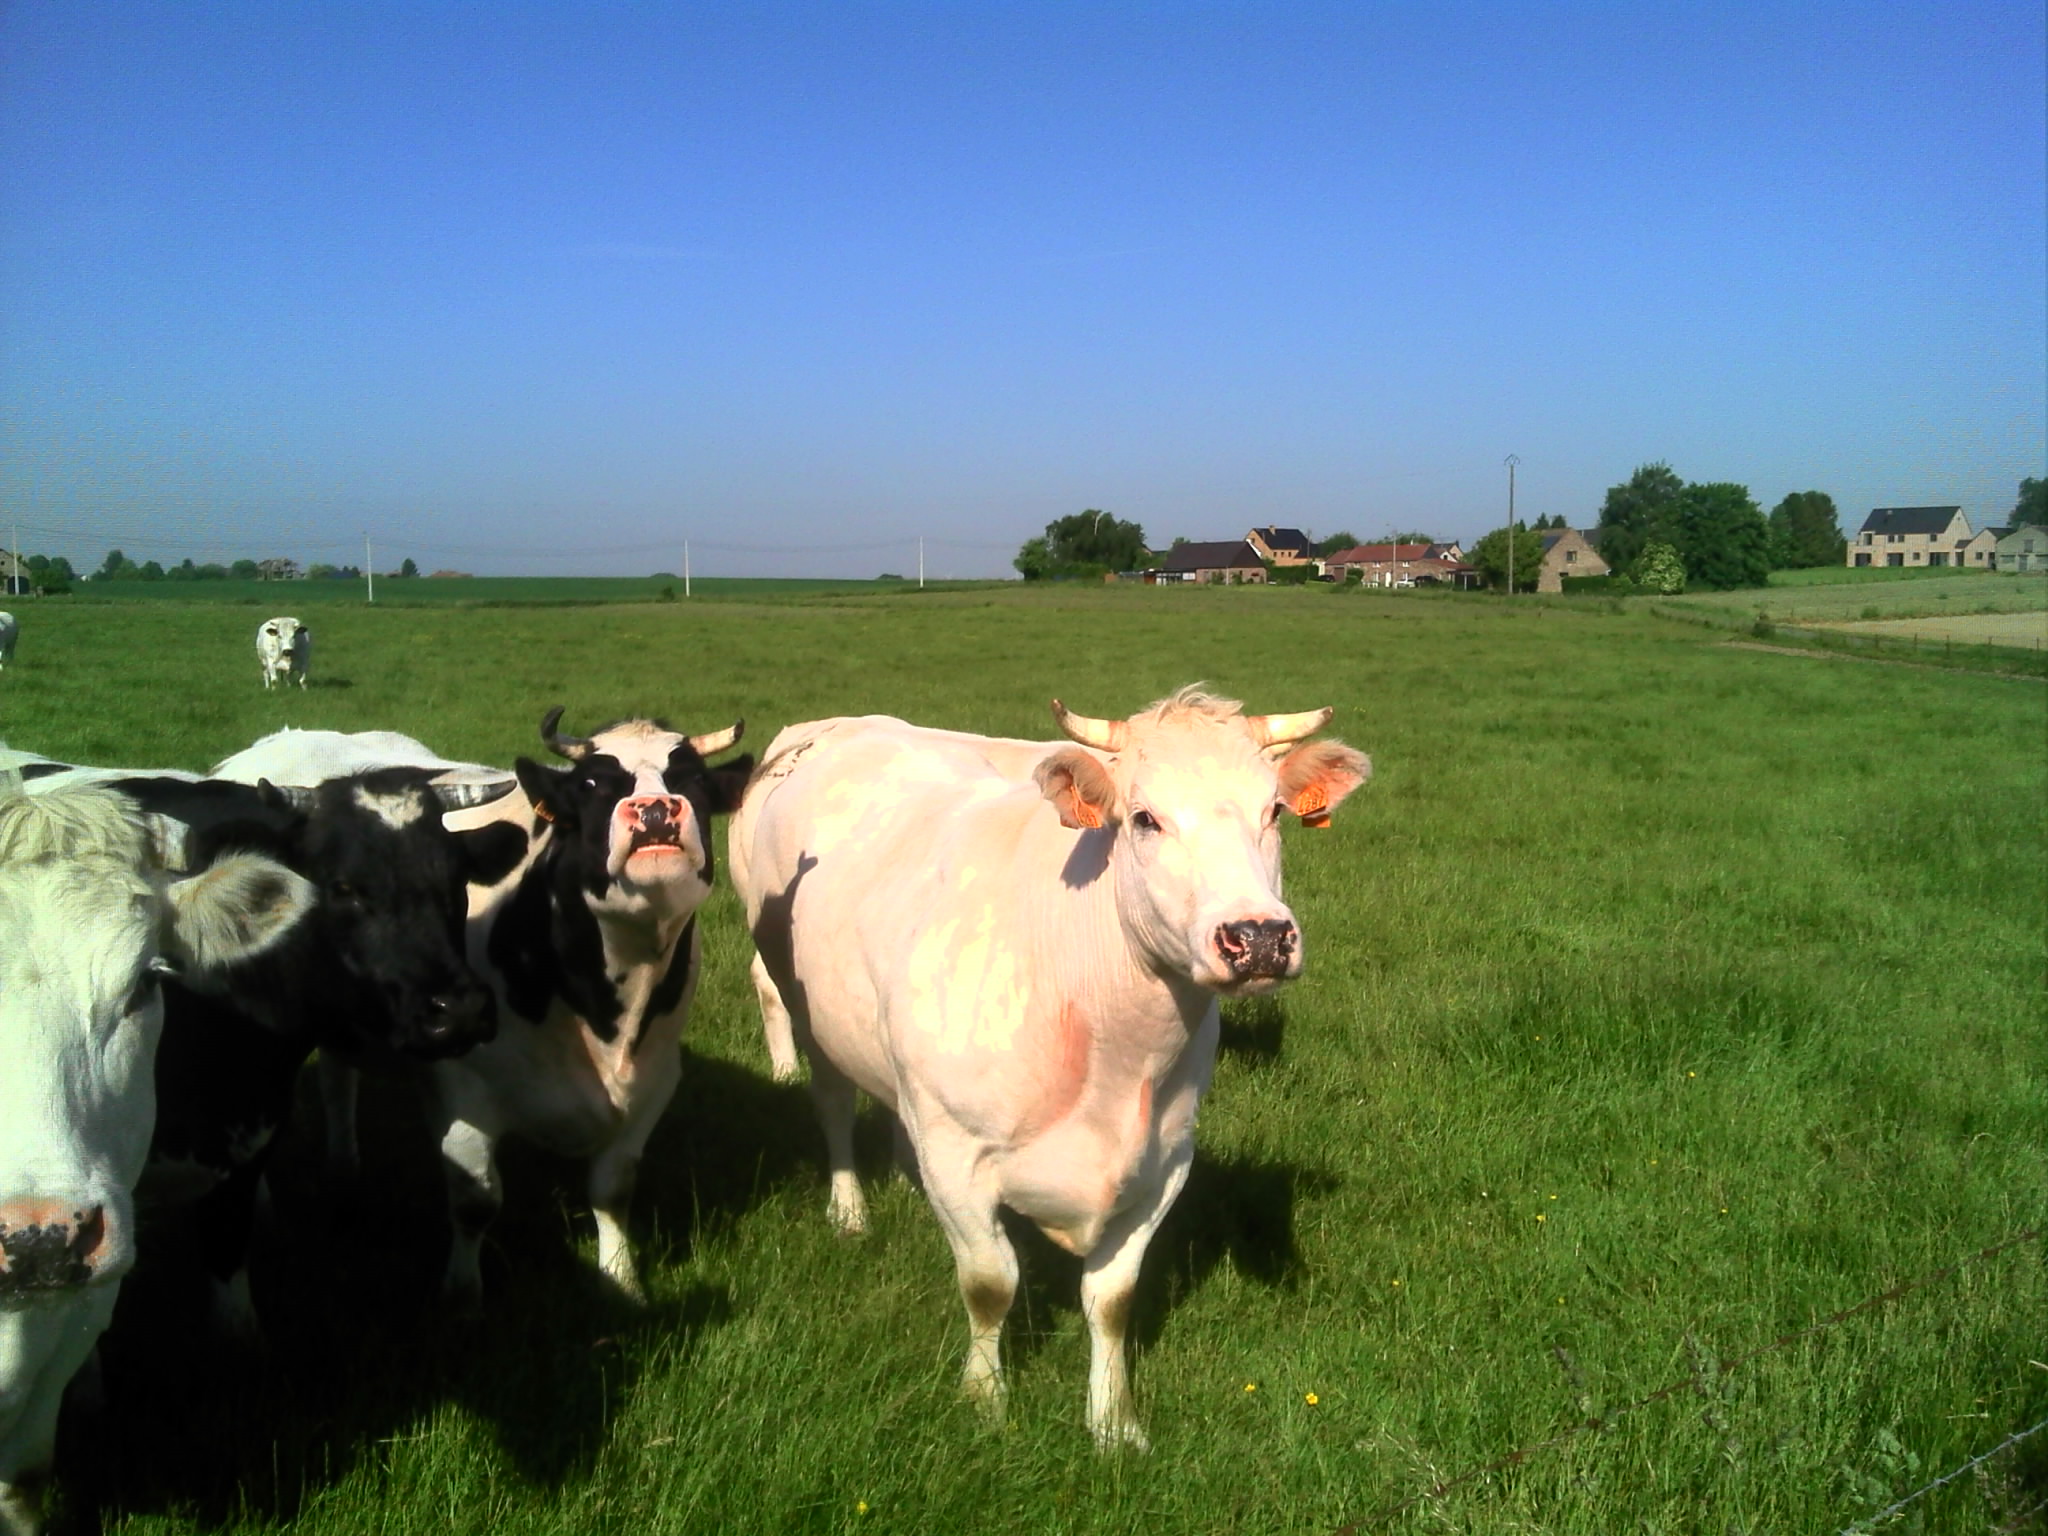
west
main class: Grassland
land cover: Grassland without tree/shrub cover
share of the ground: > 75 %
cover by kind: herbaceous plants 100 %
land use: Agriculture (excluding fallow land and kitchen gardens)
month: June
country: BE
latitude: 50.5516
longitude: 4.7886
